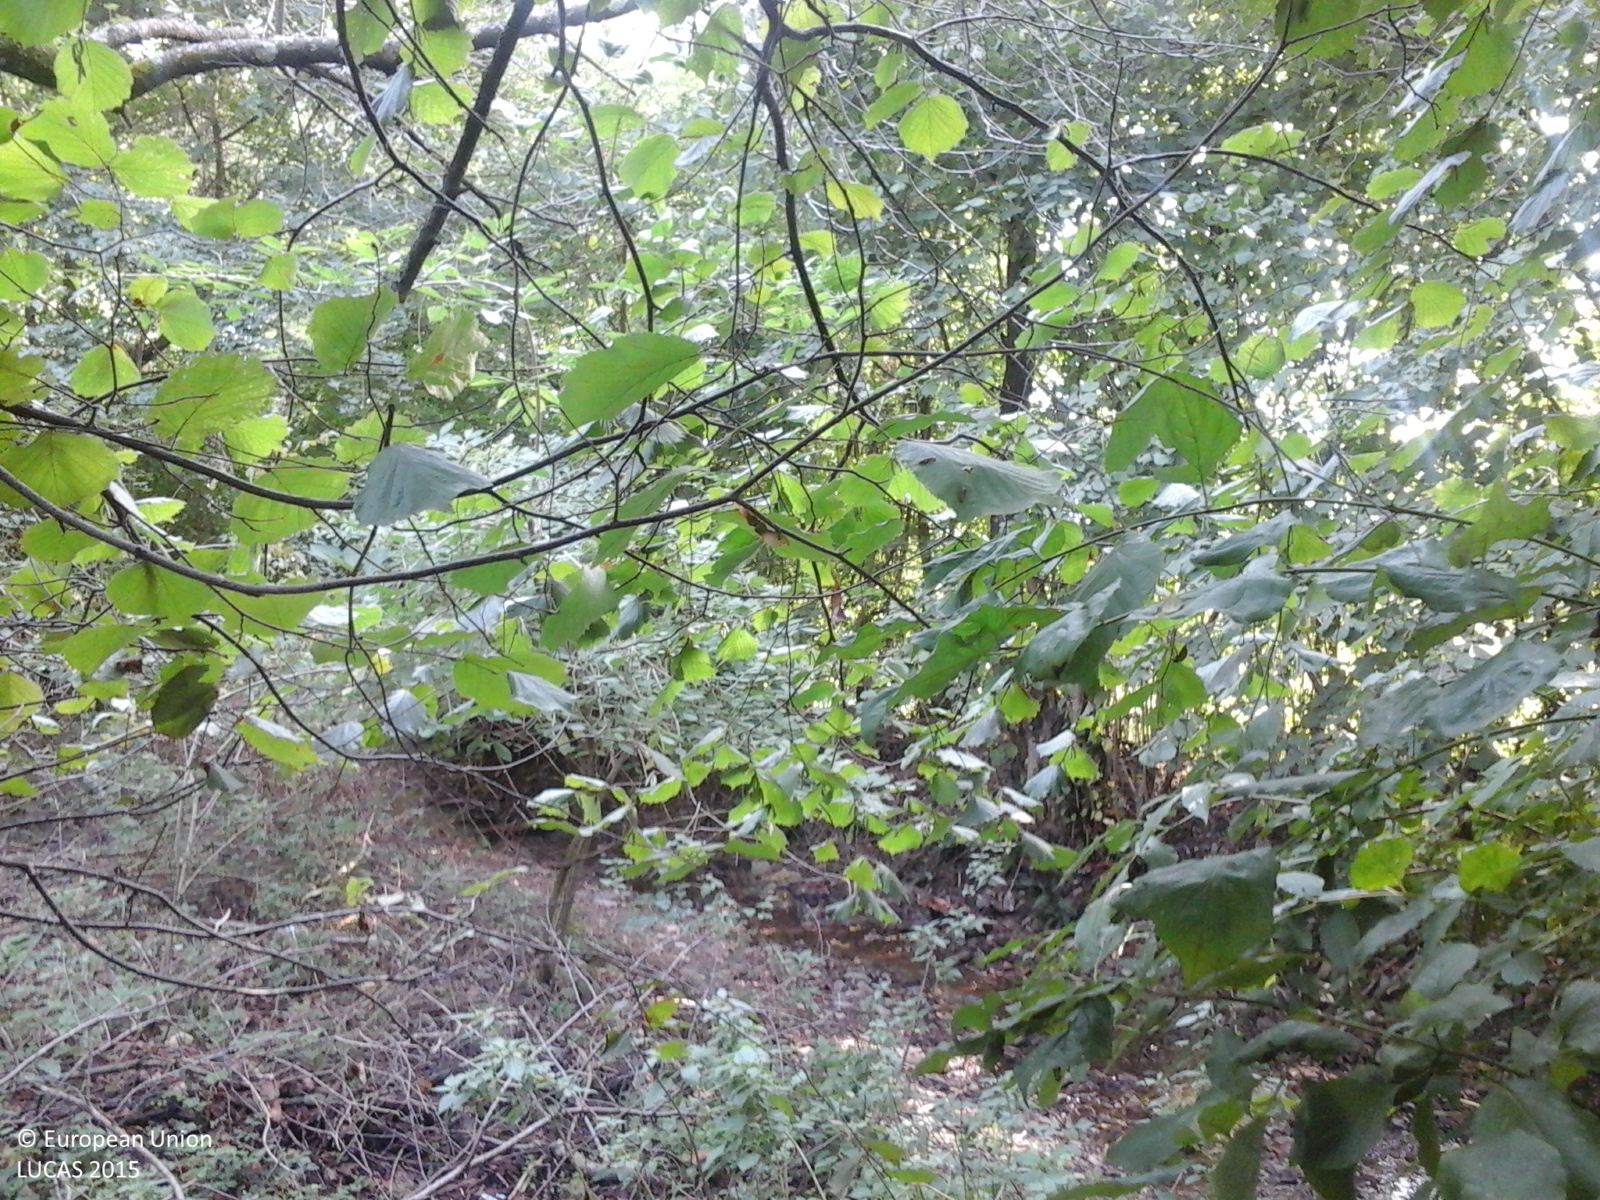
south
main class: Woodland
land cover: Broadleaved woodland
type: mesophytic deciduous forest
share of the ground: > 75 %
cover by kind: broadleaved forest trees 100 %
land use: Forestry
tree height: < 5 m
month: September
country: RO
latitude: 45.5322
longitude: 22.4269
